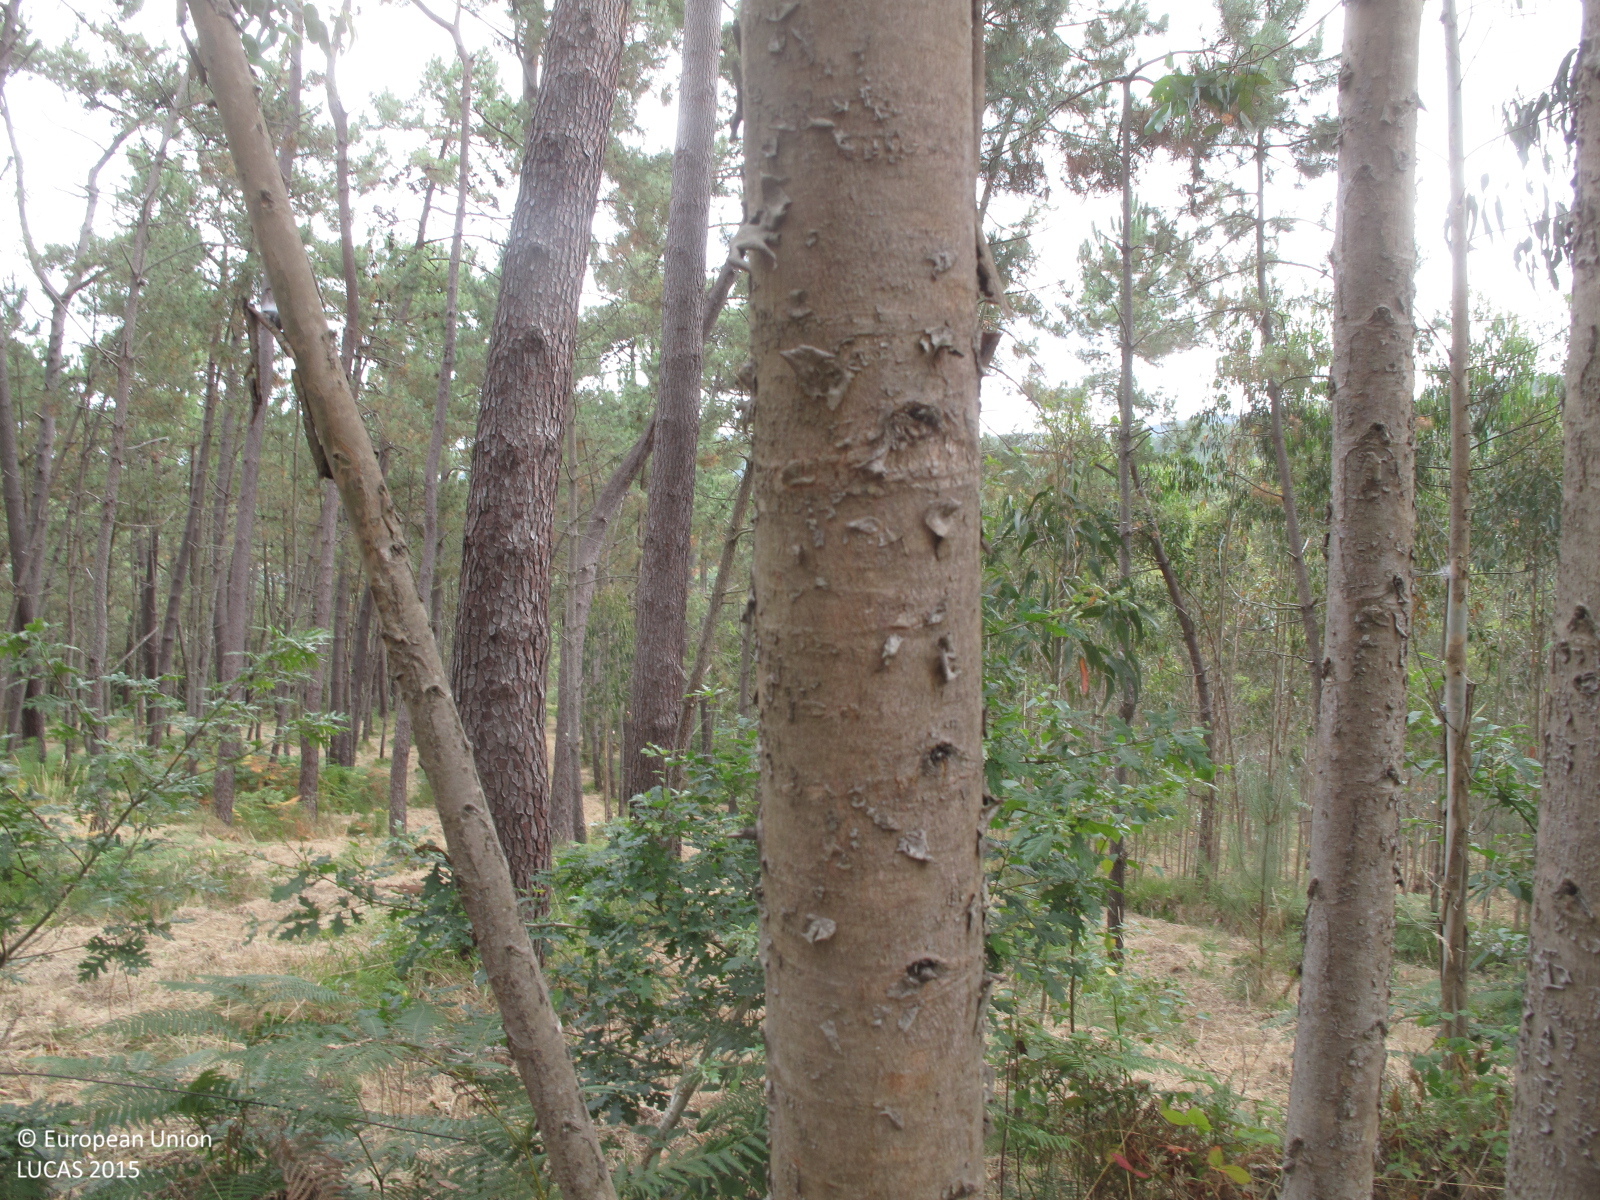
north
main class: Woodland
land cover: Broadleaved woodland
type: exotic forest
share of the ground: 25 - 50 %
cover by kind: herbaceous plants 50 %, broadleaved forest trees 40 %, shrubs 10 %
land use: Forestry
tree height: > 5 m
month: July
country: ES
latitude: 43.2727
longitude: -8.6318
